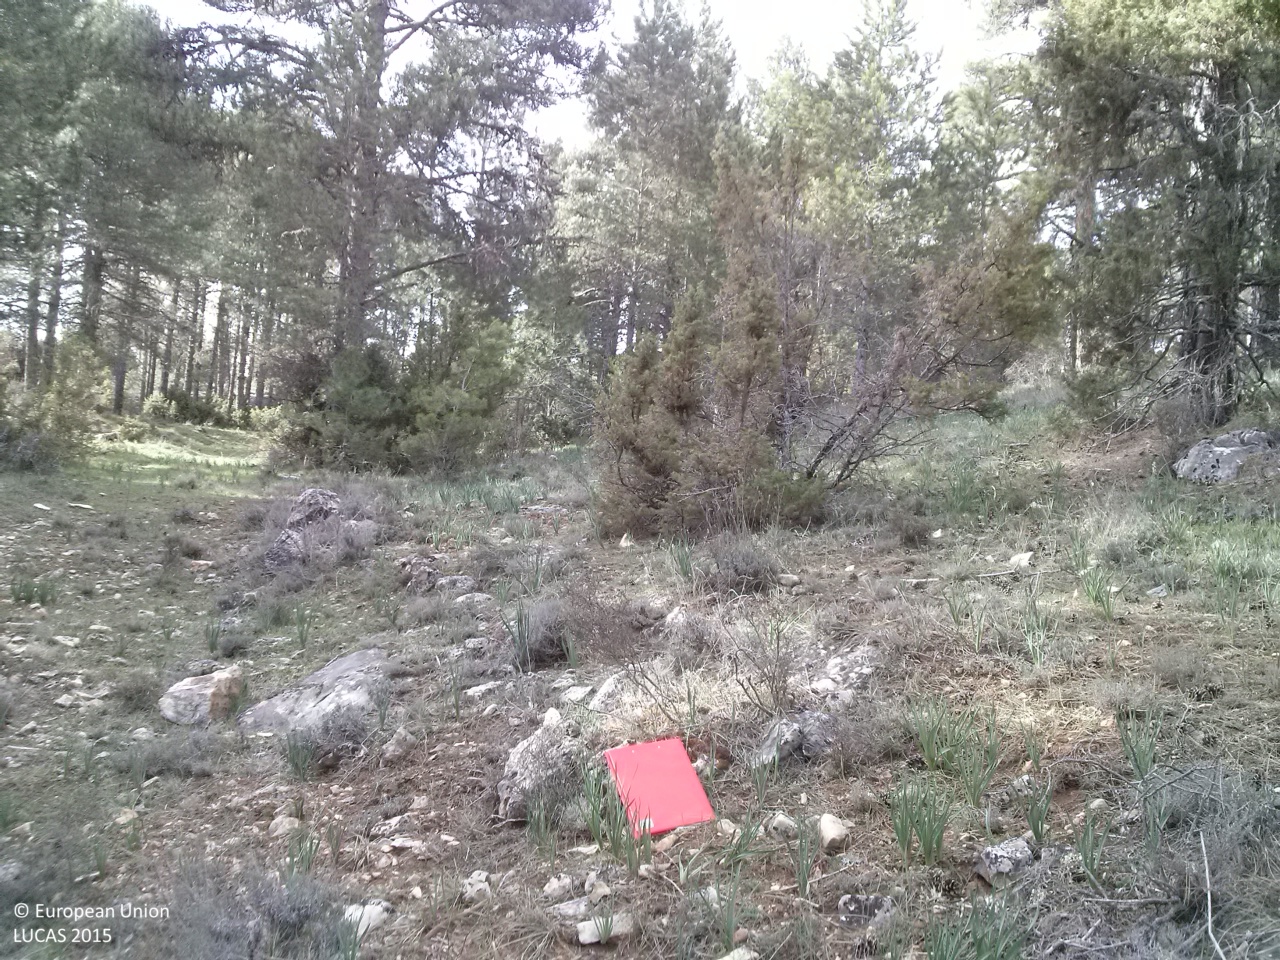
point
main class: Woodland
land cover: Pine dominated coniferous woodland
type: coniferous forest of the mediterranean region
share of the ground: 50 - 75 %
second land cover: Grassland without tree/shrub cover
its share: > 75 %
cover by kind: coniferous forest trees 60 %, herbaceous plants 30 %, consolidated bare surface 10 %
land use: Forestry
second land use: Agriculture (excluding fallow land and kitchen gardens)
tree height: > 5 m
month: April
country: ES
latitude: 40.2732
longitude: -1.8820
